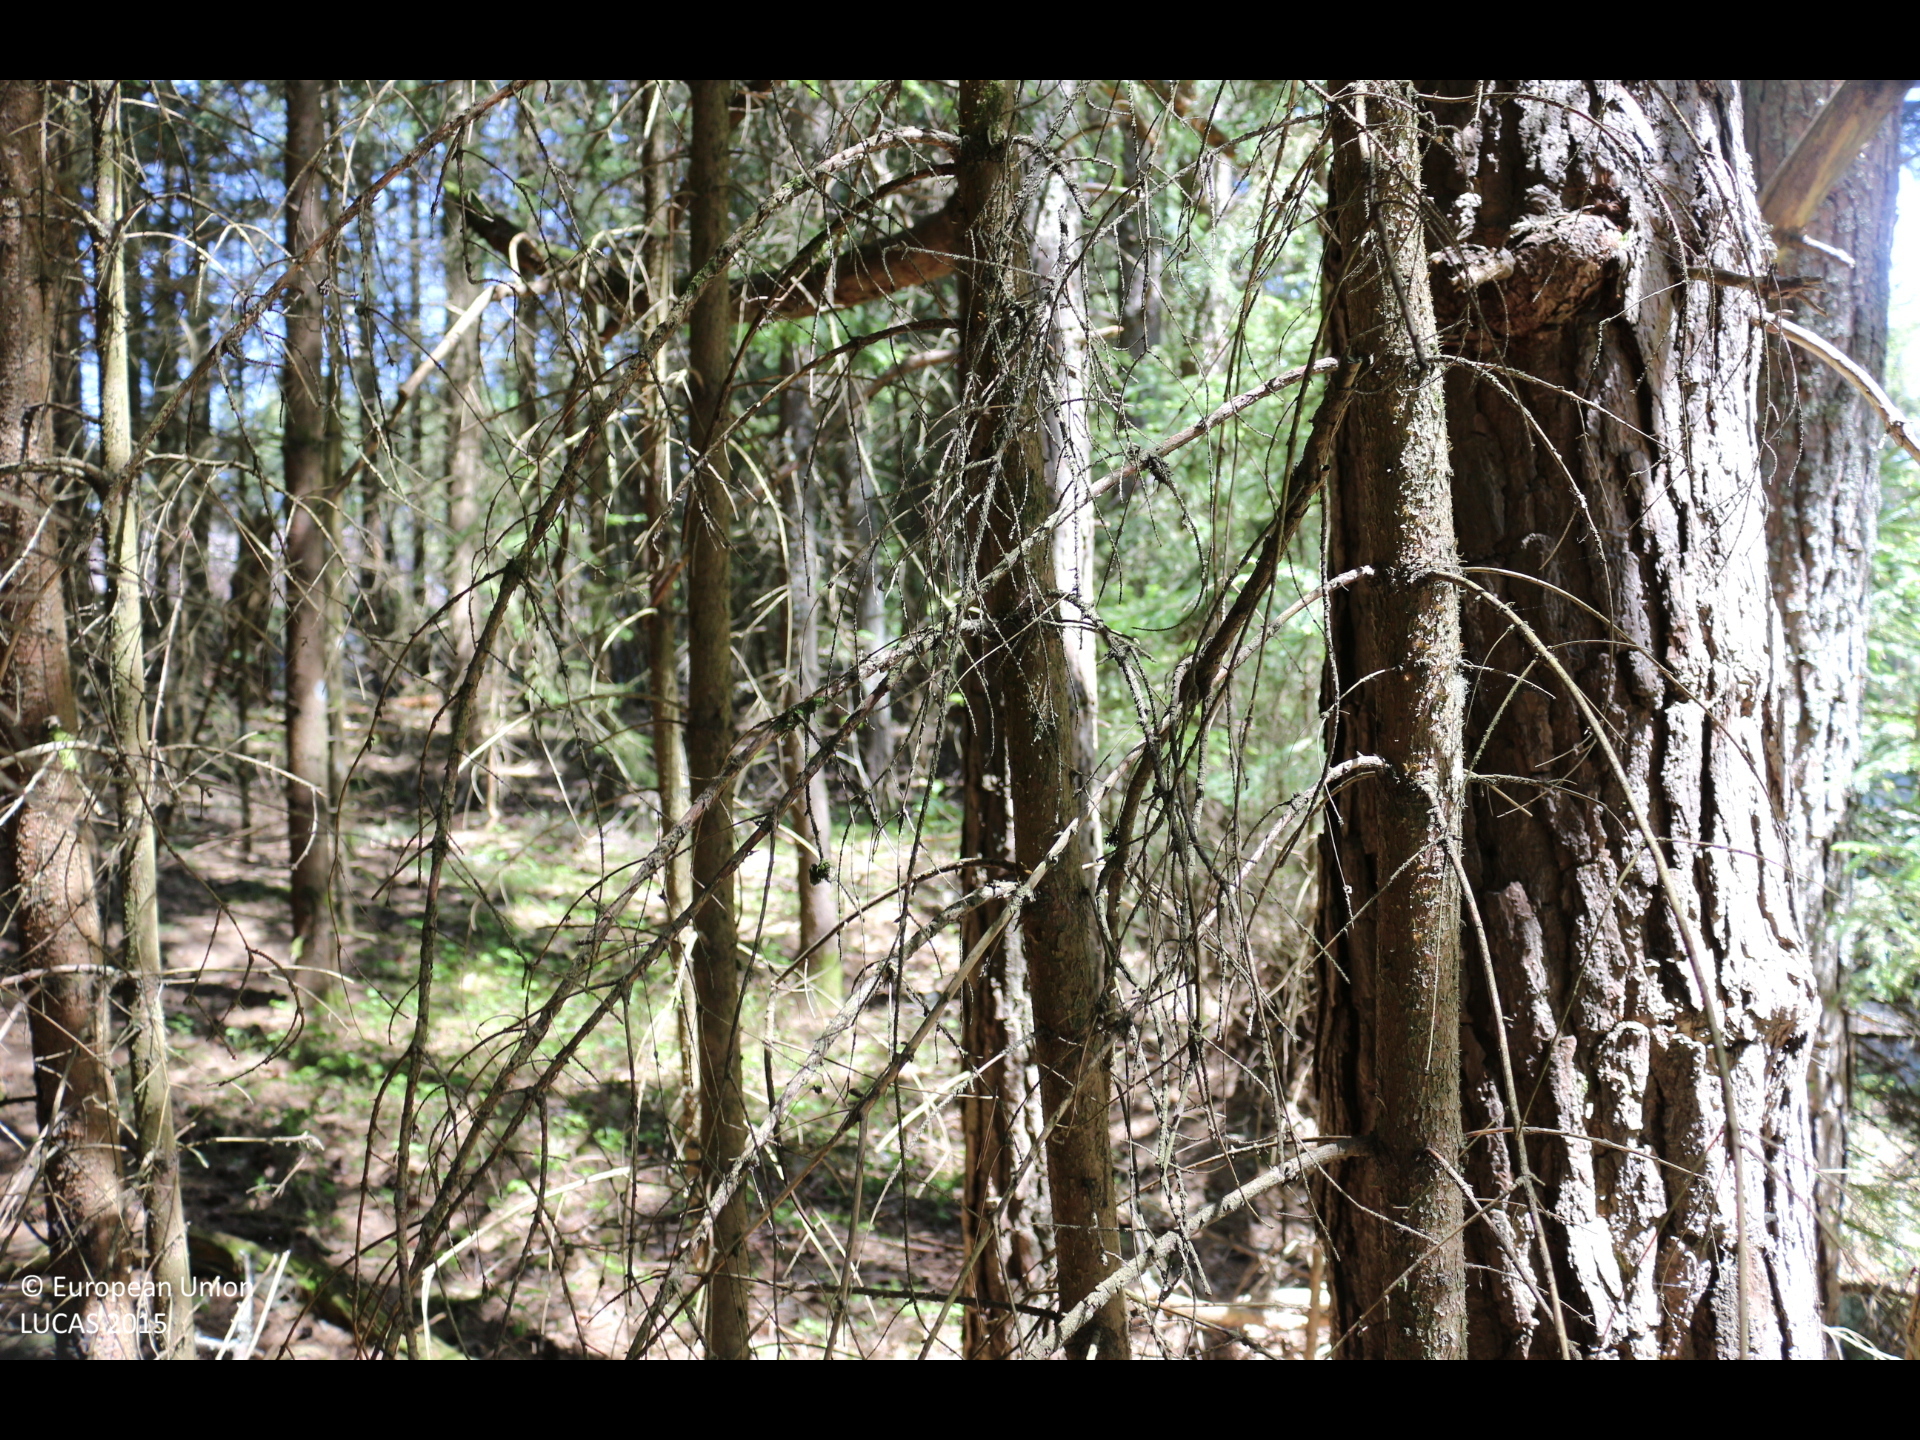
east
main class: Woodland
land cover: Spruce dominated coniferous woodland
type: alpine coniferous forest
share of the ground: > 75 %
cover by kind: coniferous forest trees 100 %
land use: Forestry
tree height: > 5 m
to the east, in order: Spruce dominated coniferous woodland; Tracks; Grassland with sparse tree/shrub cover; Artificial constructions in urban areas; Grassland without tree/shrub cover; Grassland with sparse tree/shrub cover; Other mixed woodland; Tracks; Spruce dominated coniferous woodland
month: May
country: AT
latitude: 46.8065
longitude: 14.2828
